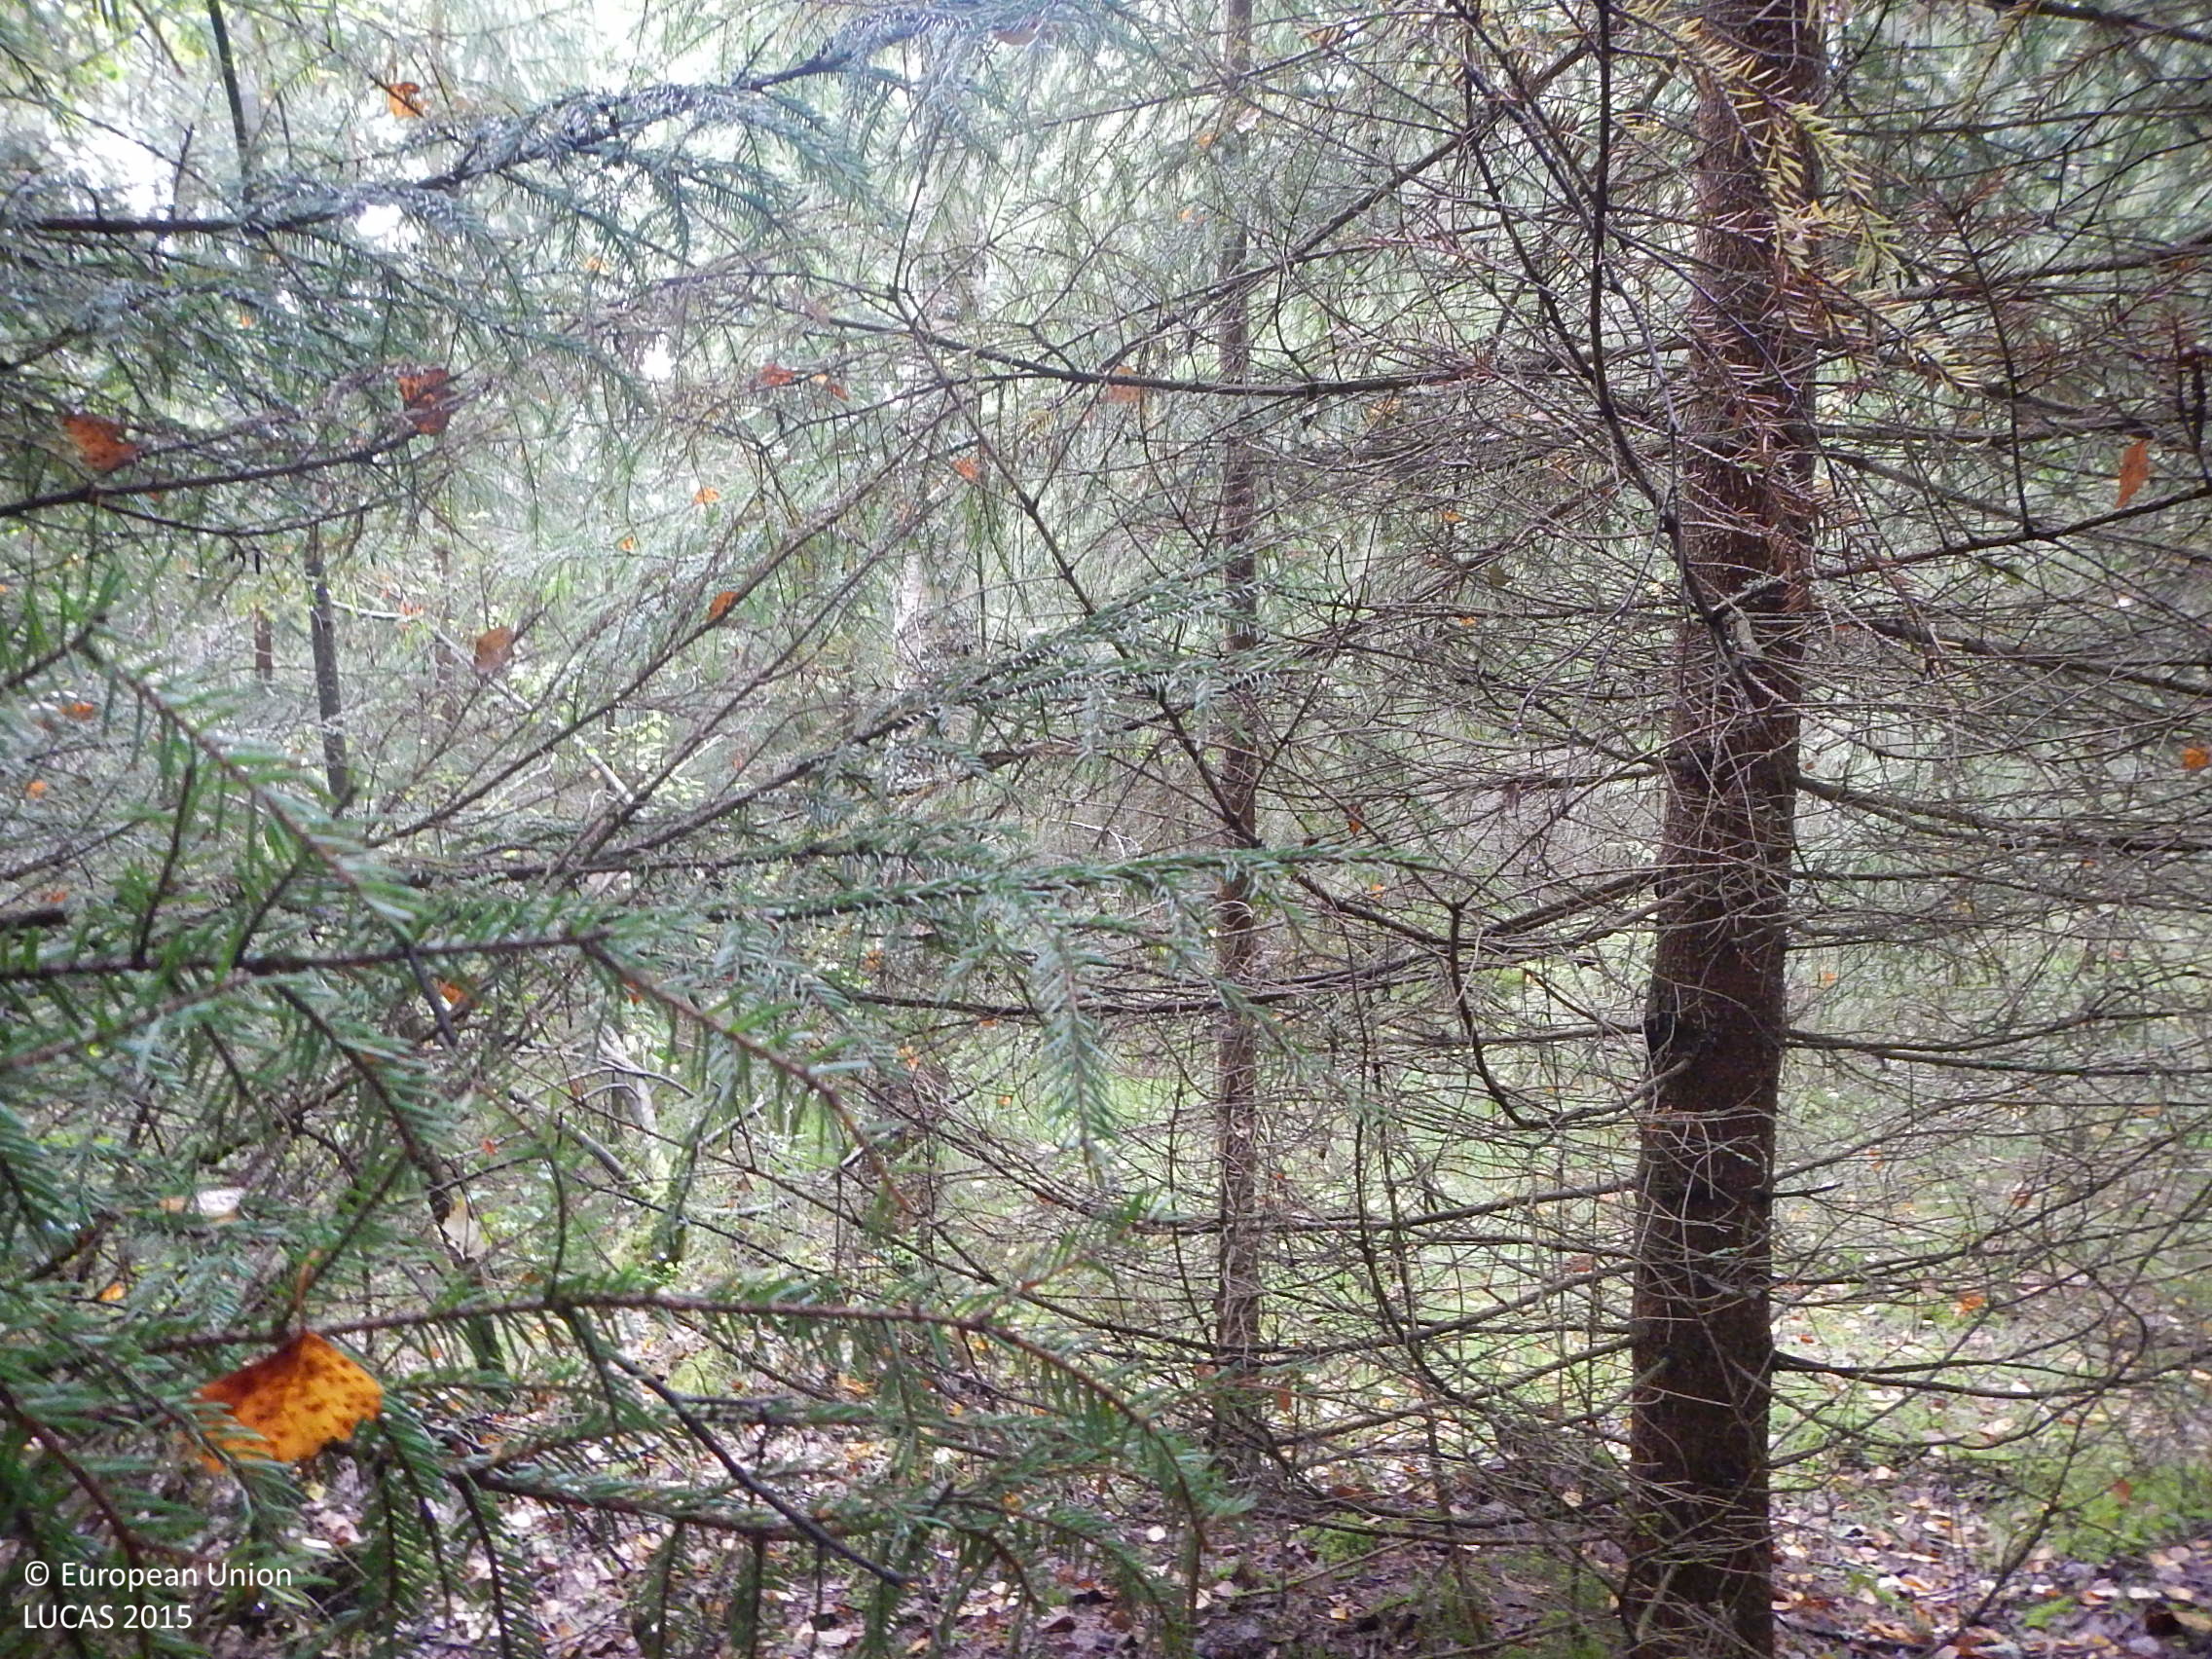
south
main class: Woodland
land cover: Other mixed woodland
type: boreal forest
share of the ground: > 75 %
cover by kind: coniferous forest trees 65 %, broadleaved forest trees 30 %, lichens and mosses 5 %
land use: Forestry
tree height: > 5 m
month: September
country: FI
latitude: 61.4566
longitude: 23.0355
